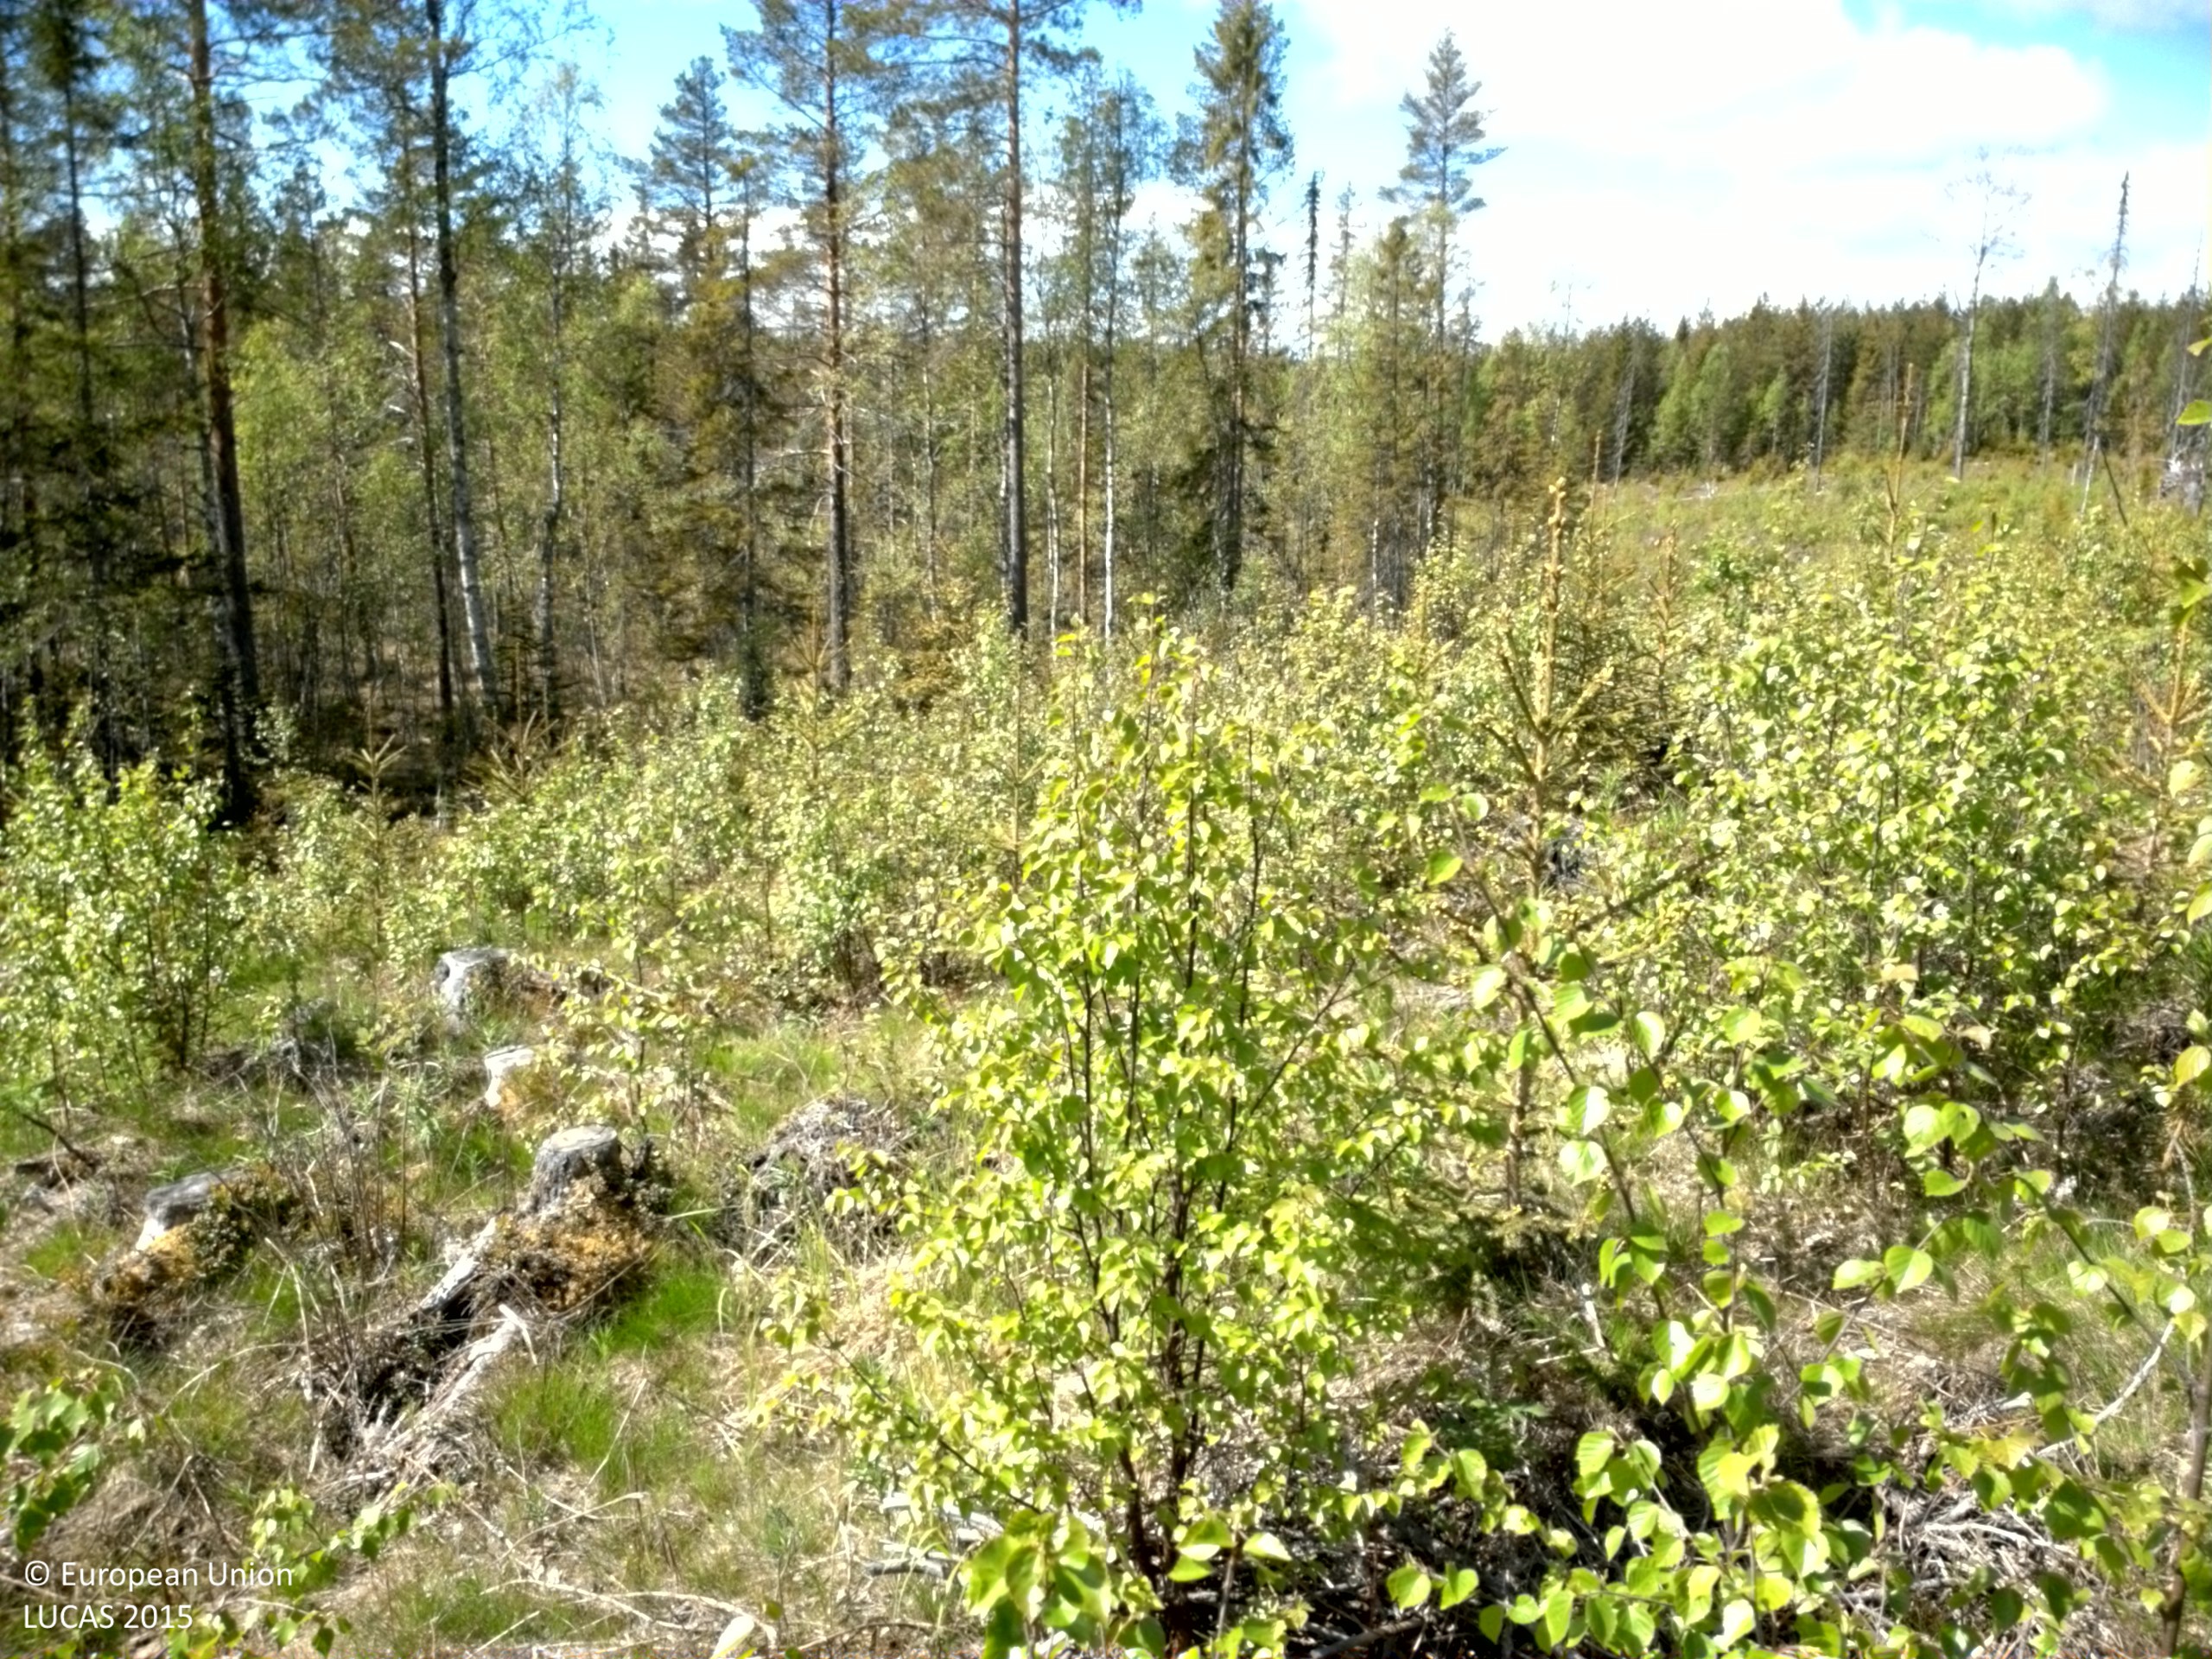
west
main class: Woodland
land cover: Broadleaved woodland
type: boreal forest
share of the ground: > 75 %
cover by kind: broadleaved forest trees 80 %, coniferous forest trees 10 %, herbaceous plants 10 %
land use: Forestry
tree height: < 5 m
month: June
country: SE
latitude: 63.0760
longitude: 17.1619
